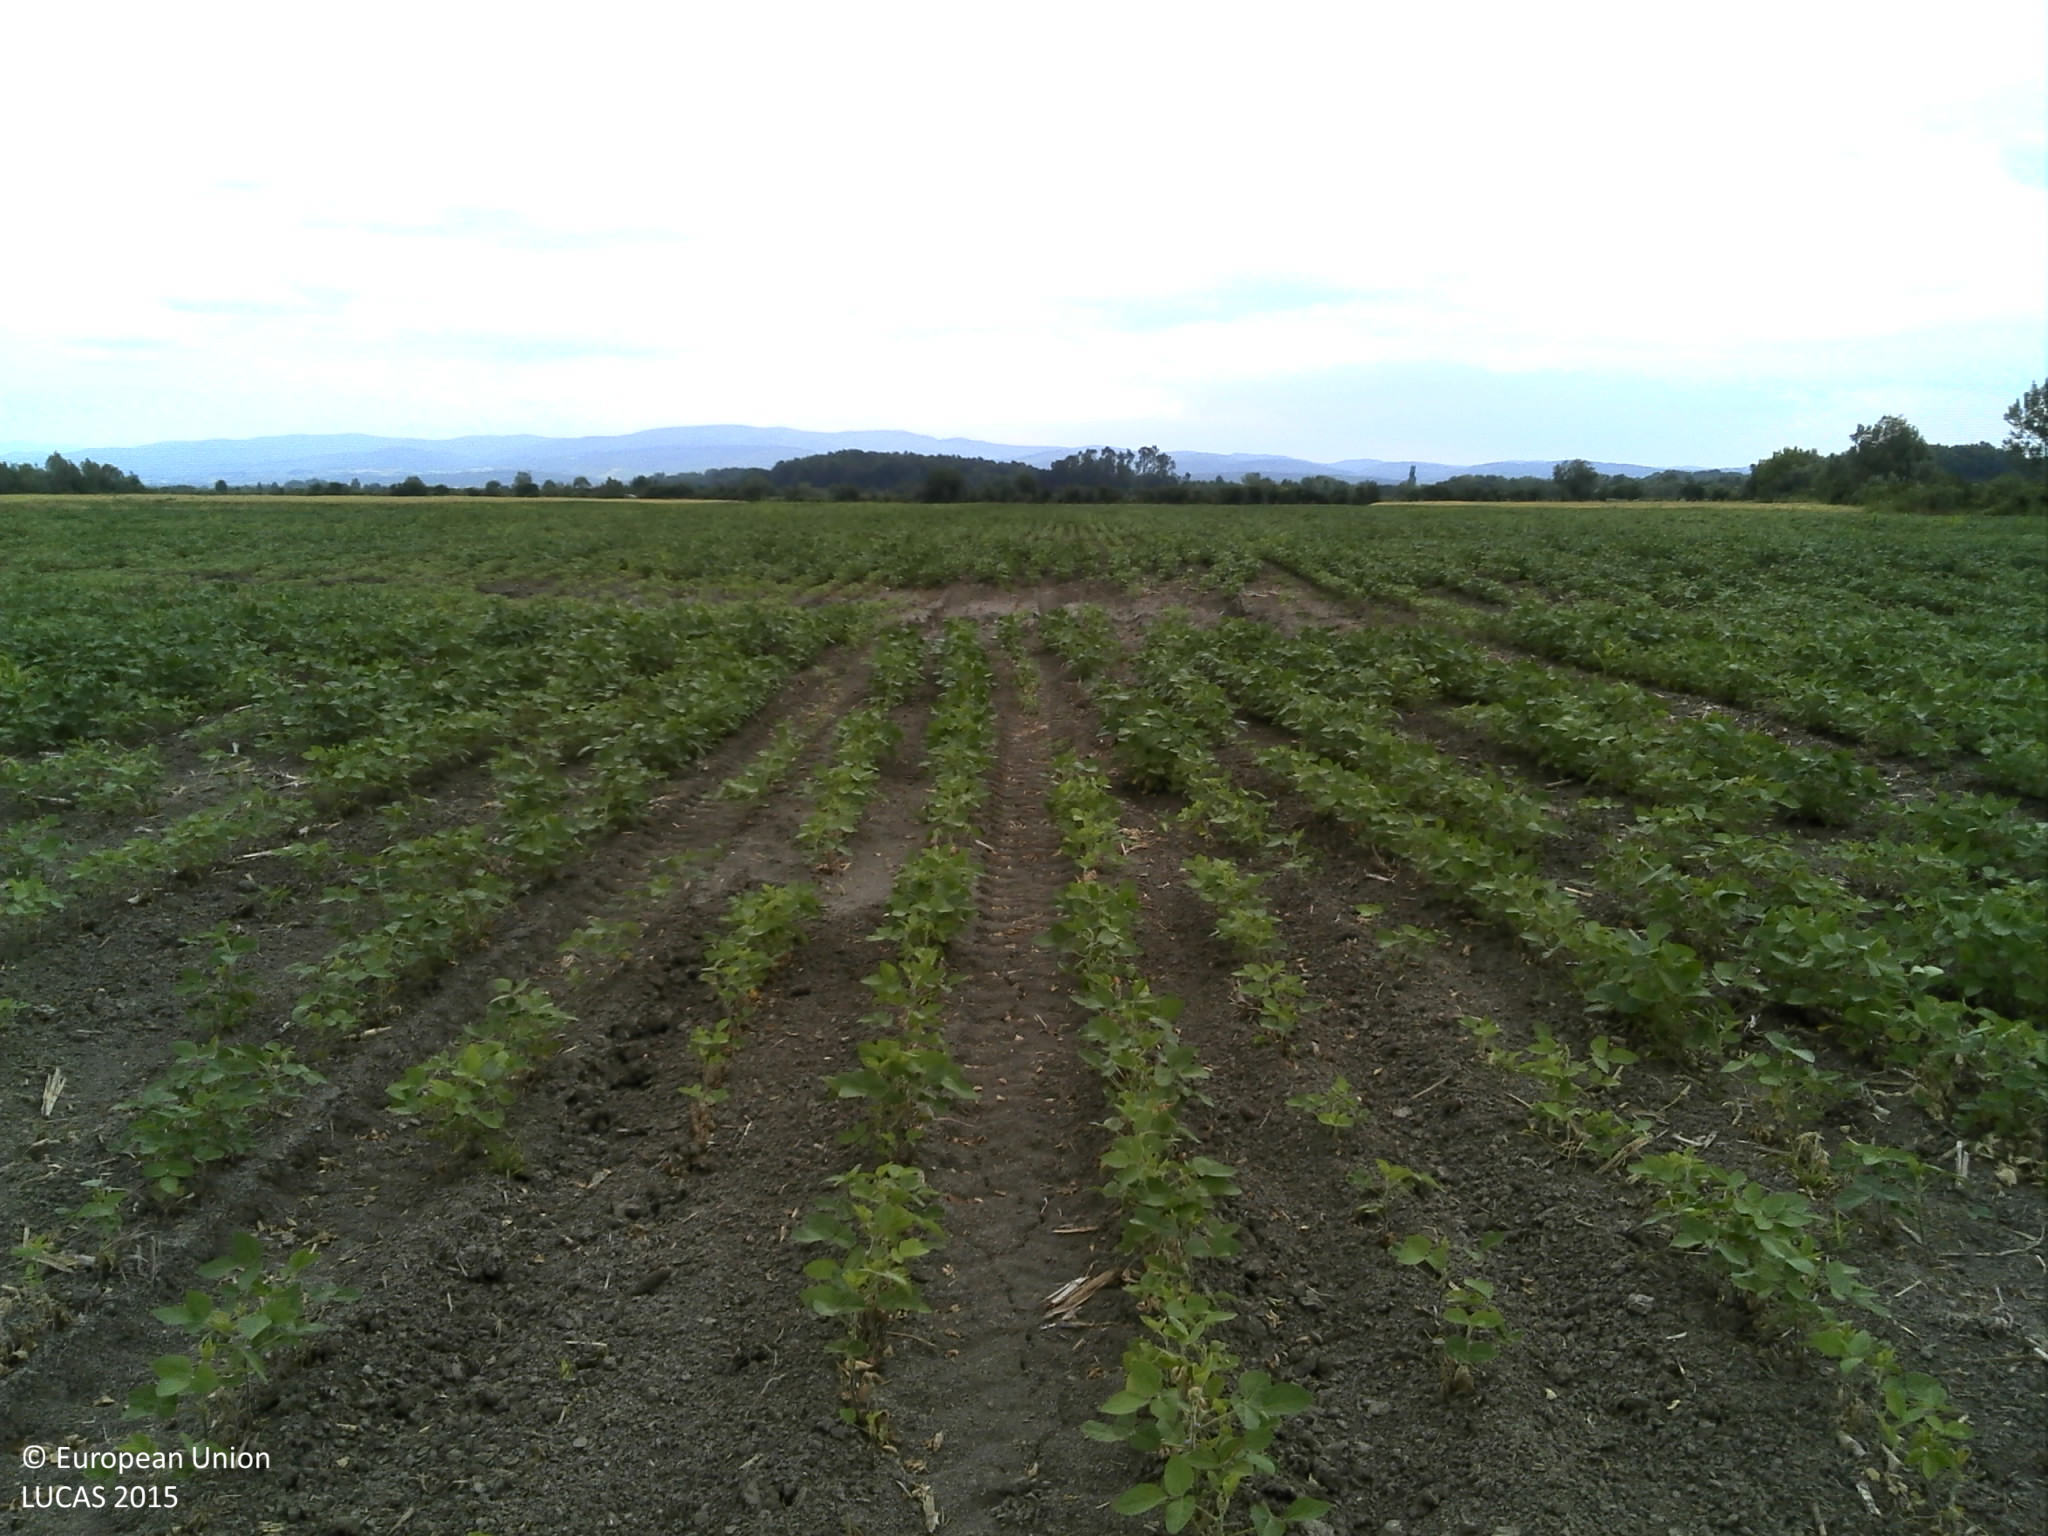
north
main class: Cropland
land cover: Soya
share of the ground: 25 - 50 %
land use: Agriculture (excluding fallow land and kitchen gardens)
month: June
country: HR
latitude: 45.1582
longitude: 17.5950
